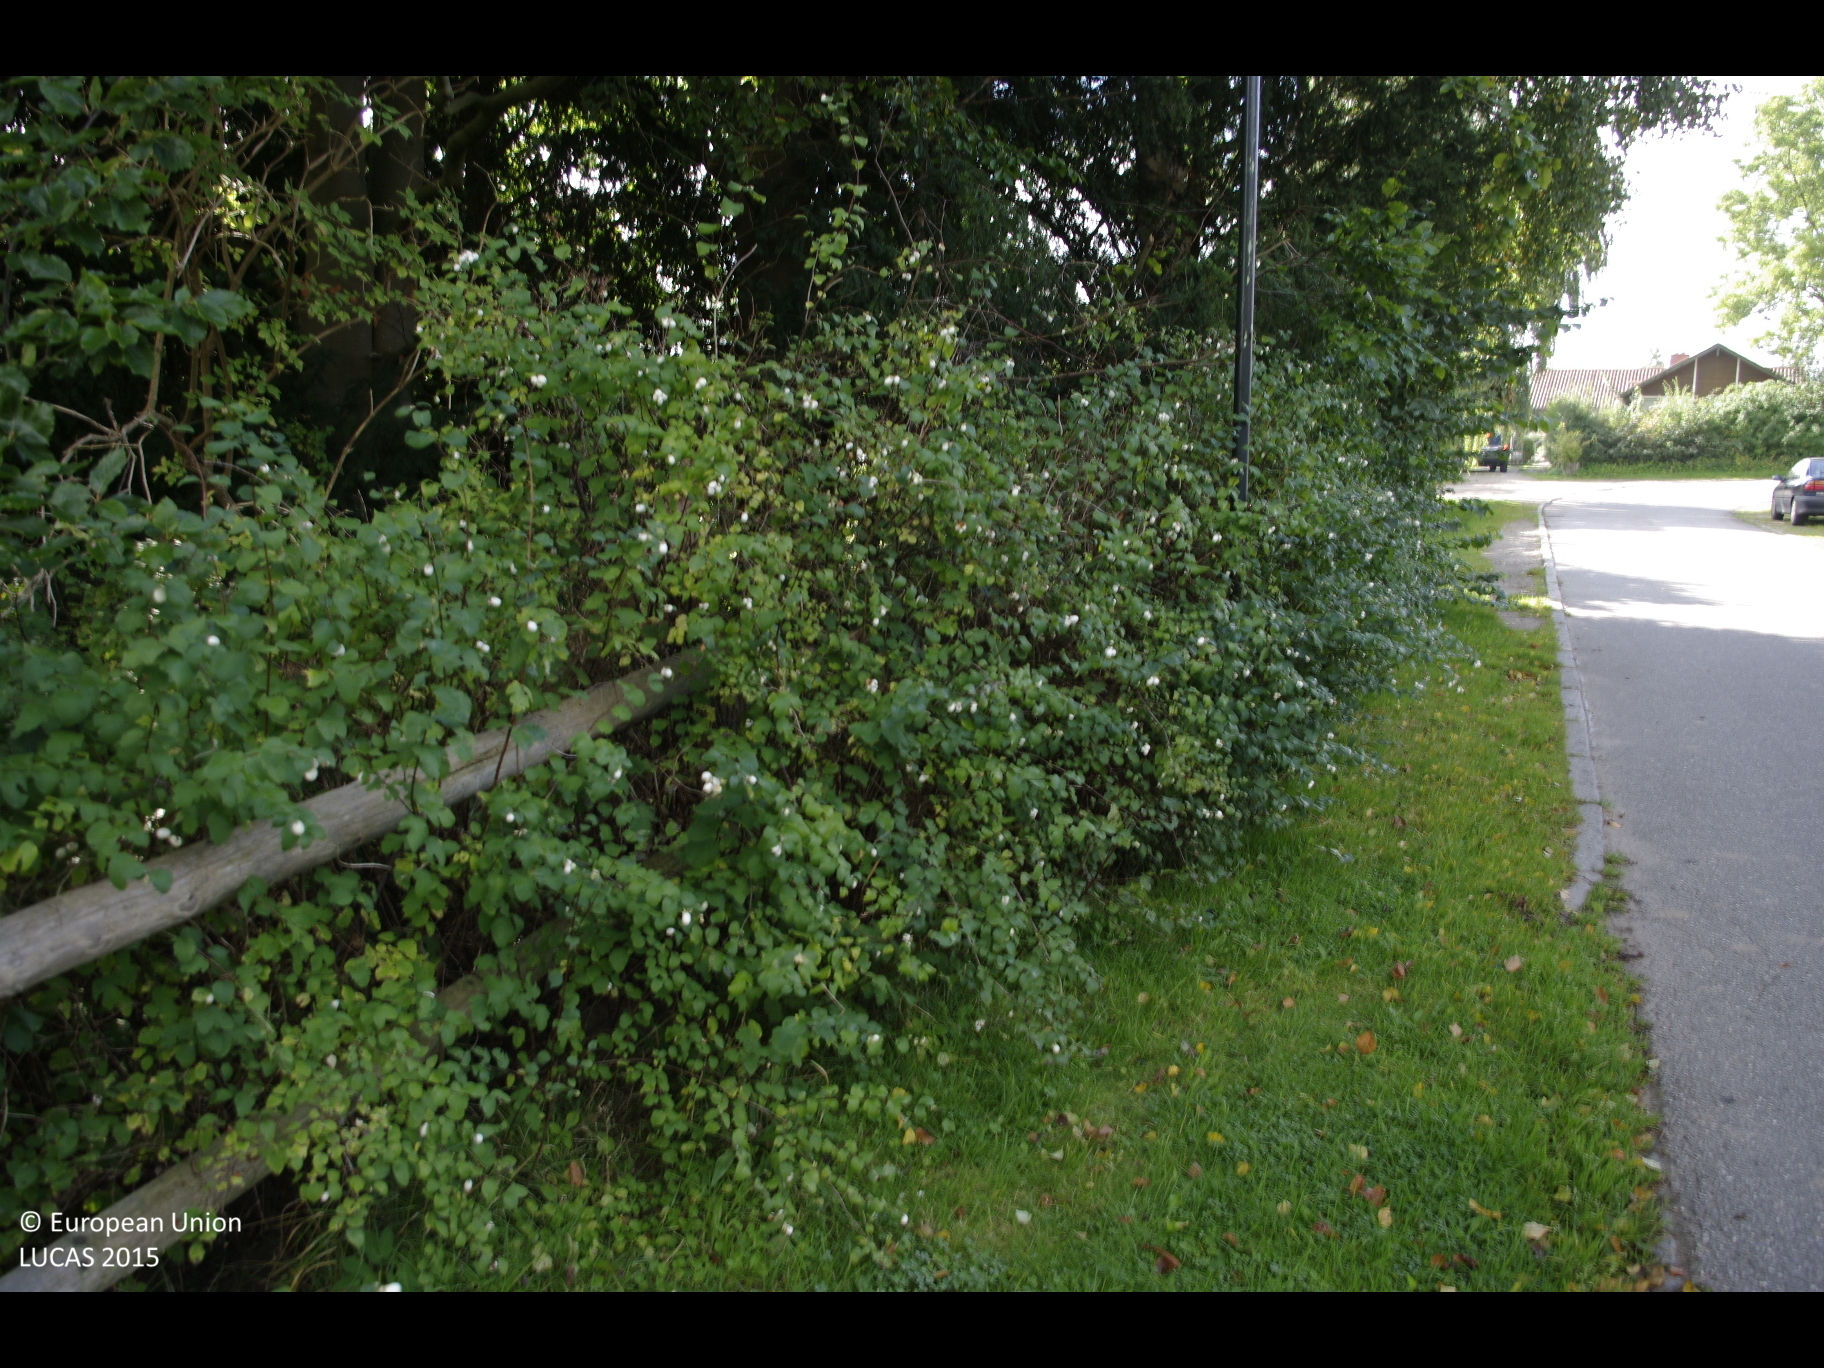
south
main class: Woodland
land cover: Other mixed woodland
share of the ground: > 75 %
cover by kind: coniferous forest trees 50 %, broadleaved forest trees 40 %, shrubs 10 %
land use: Residential
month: September
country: DE
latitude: 53.9934
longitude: 10.6250
